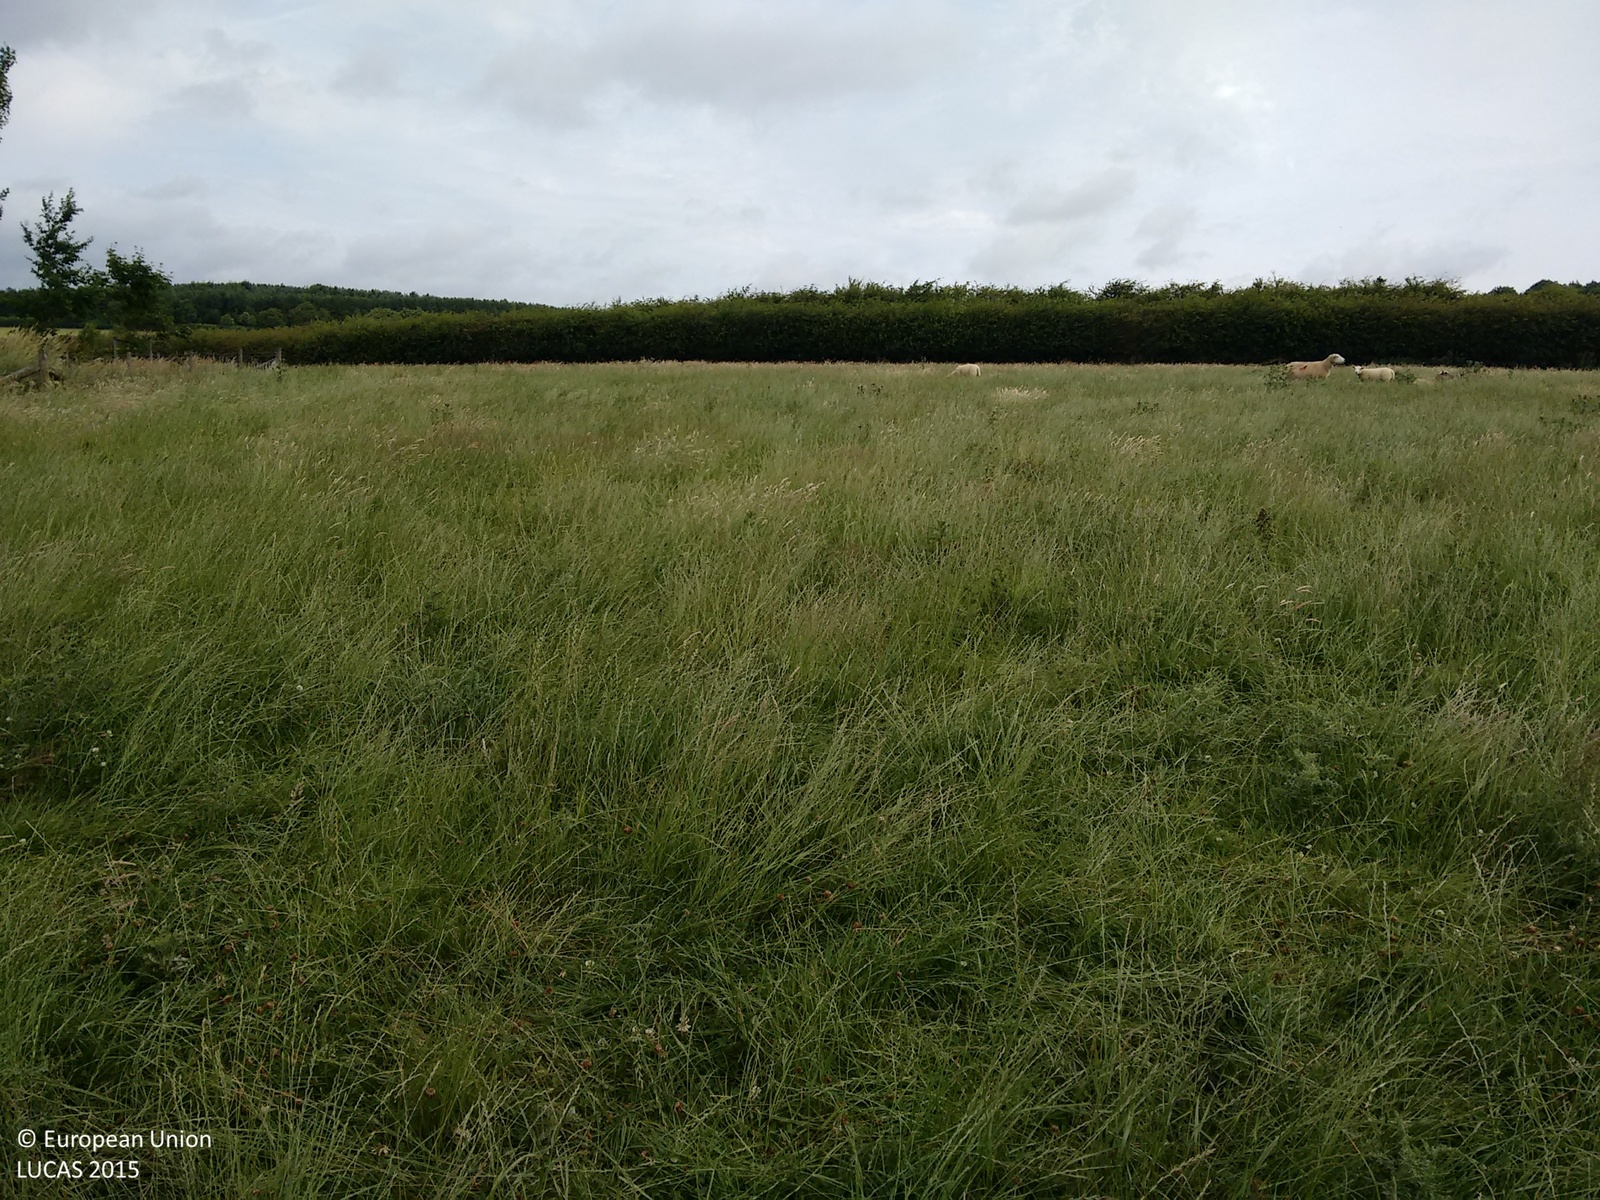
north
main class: Grassland
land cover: Grassland without tree/shrub cover
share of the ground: > 75 %
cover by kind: herbaceous plants 100 %
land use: Agriculture (excluding fallow land and kitchen gardens)
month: July
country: GB
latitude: 52.6287
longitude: -0.7821
